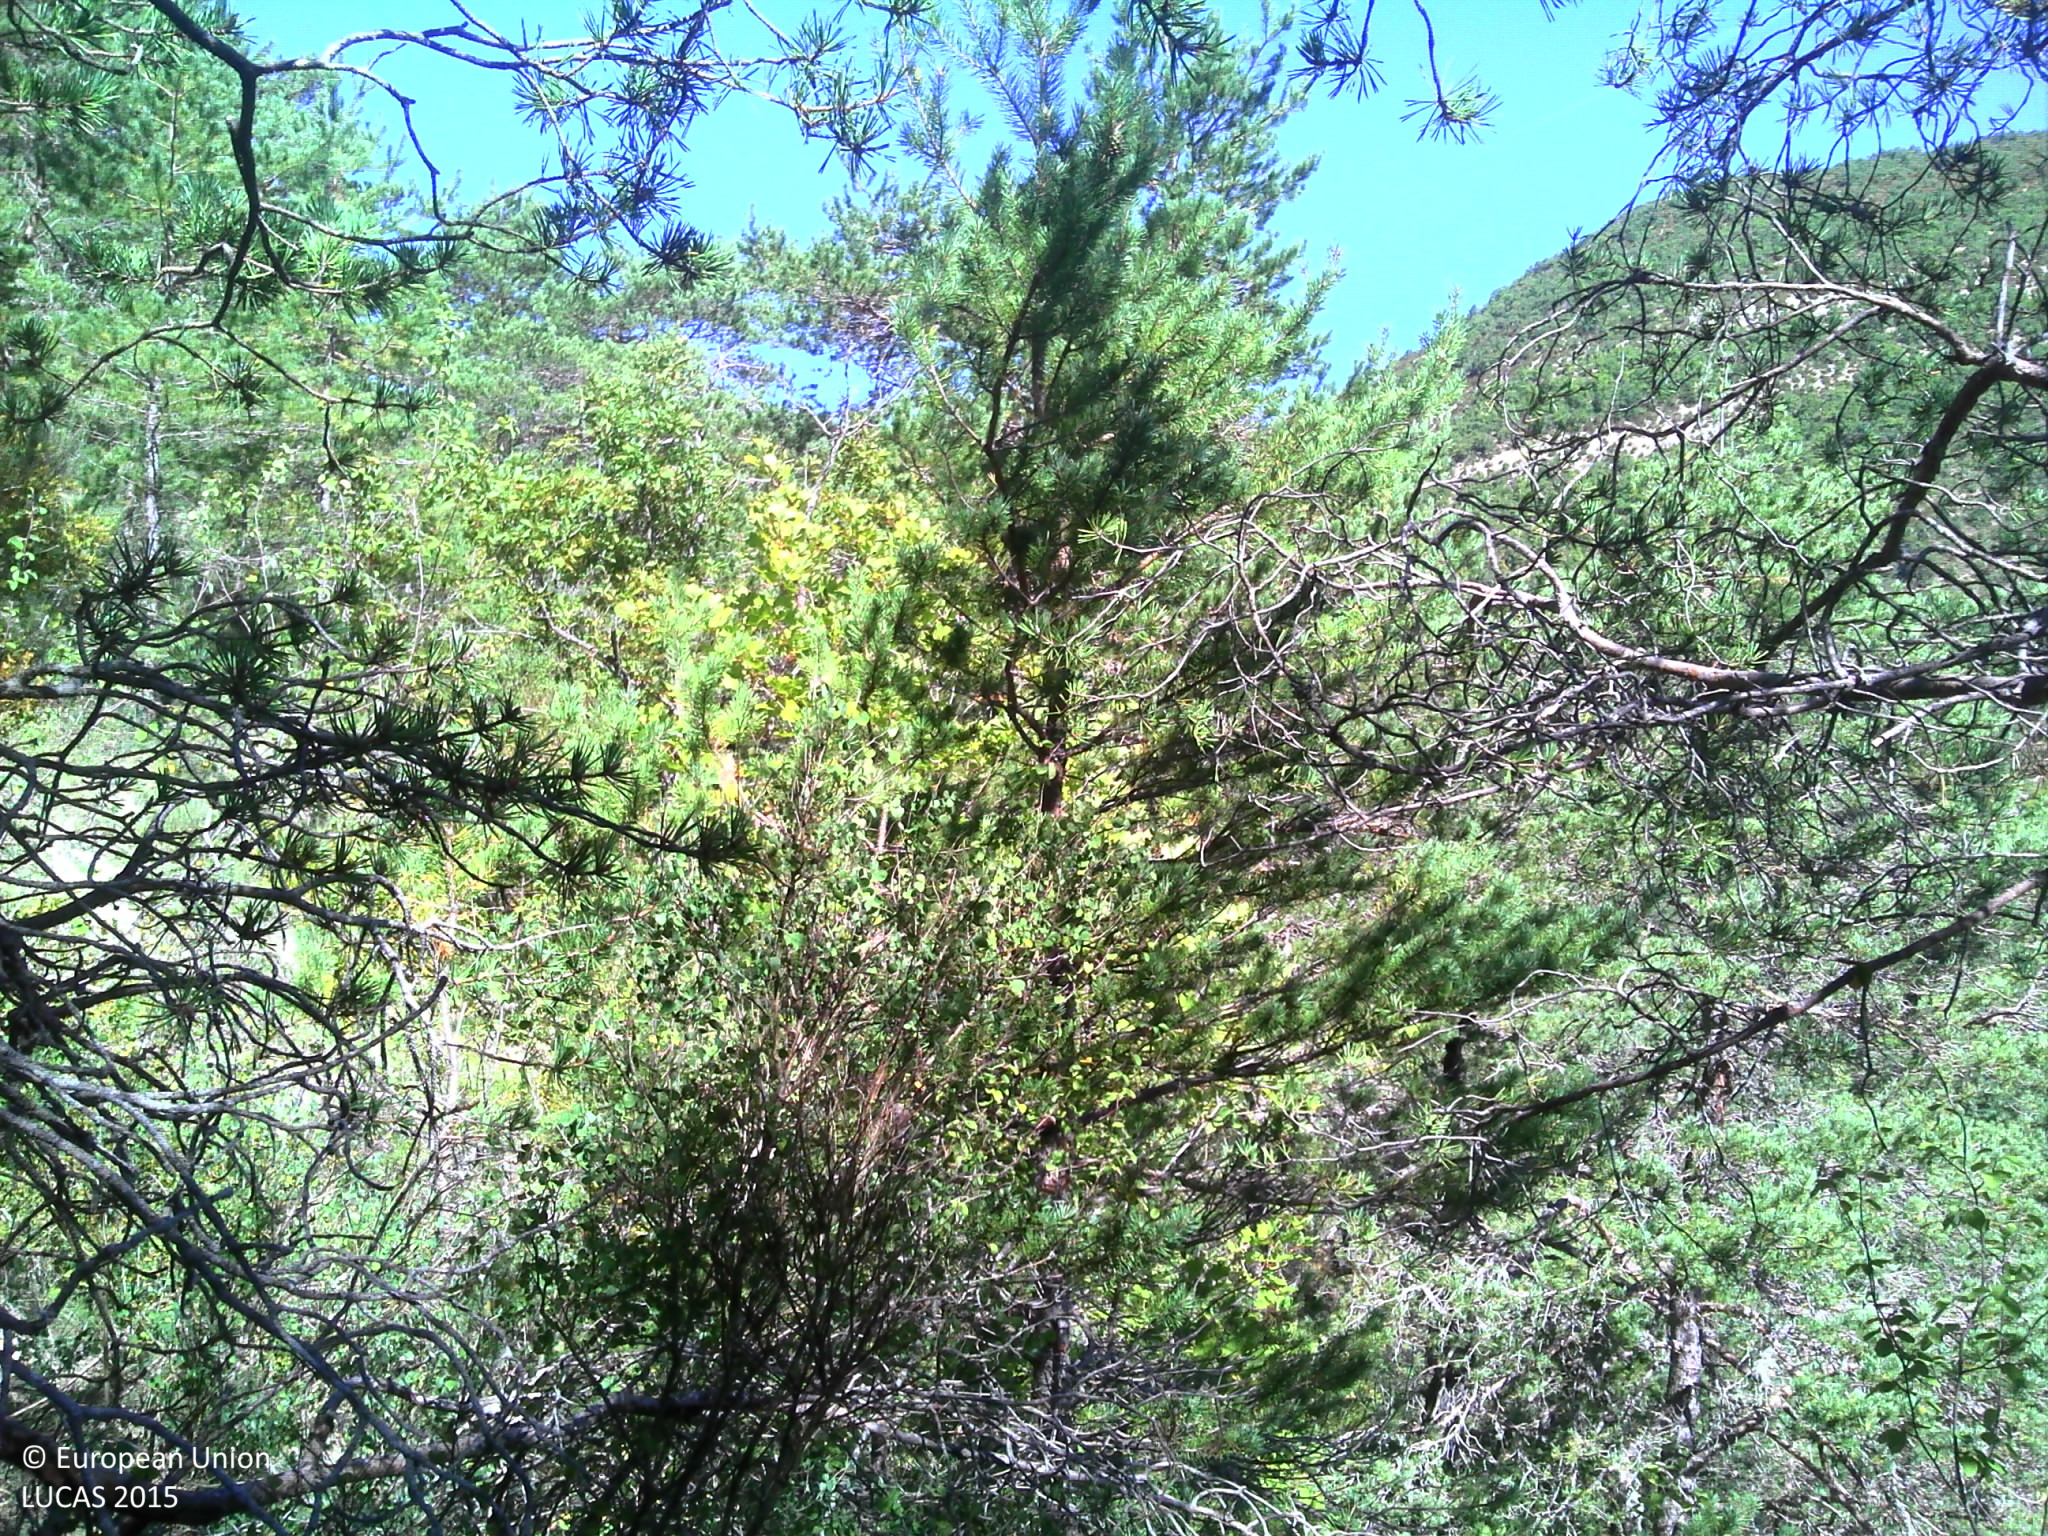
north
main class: Woodland
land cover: Pine dominated coniferous woodland
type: coniferous forest of the mediterranean region
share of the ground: > 75 %
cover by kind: coniferous forest trees 95 %, broadleaved forest trees 5 %
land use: Semi-natural and natural areas not in use
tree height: > 5 m
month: September
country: FR
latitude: 44.3265
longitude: 5.5307
